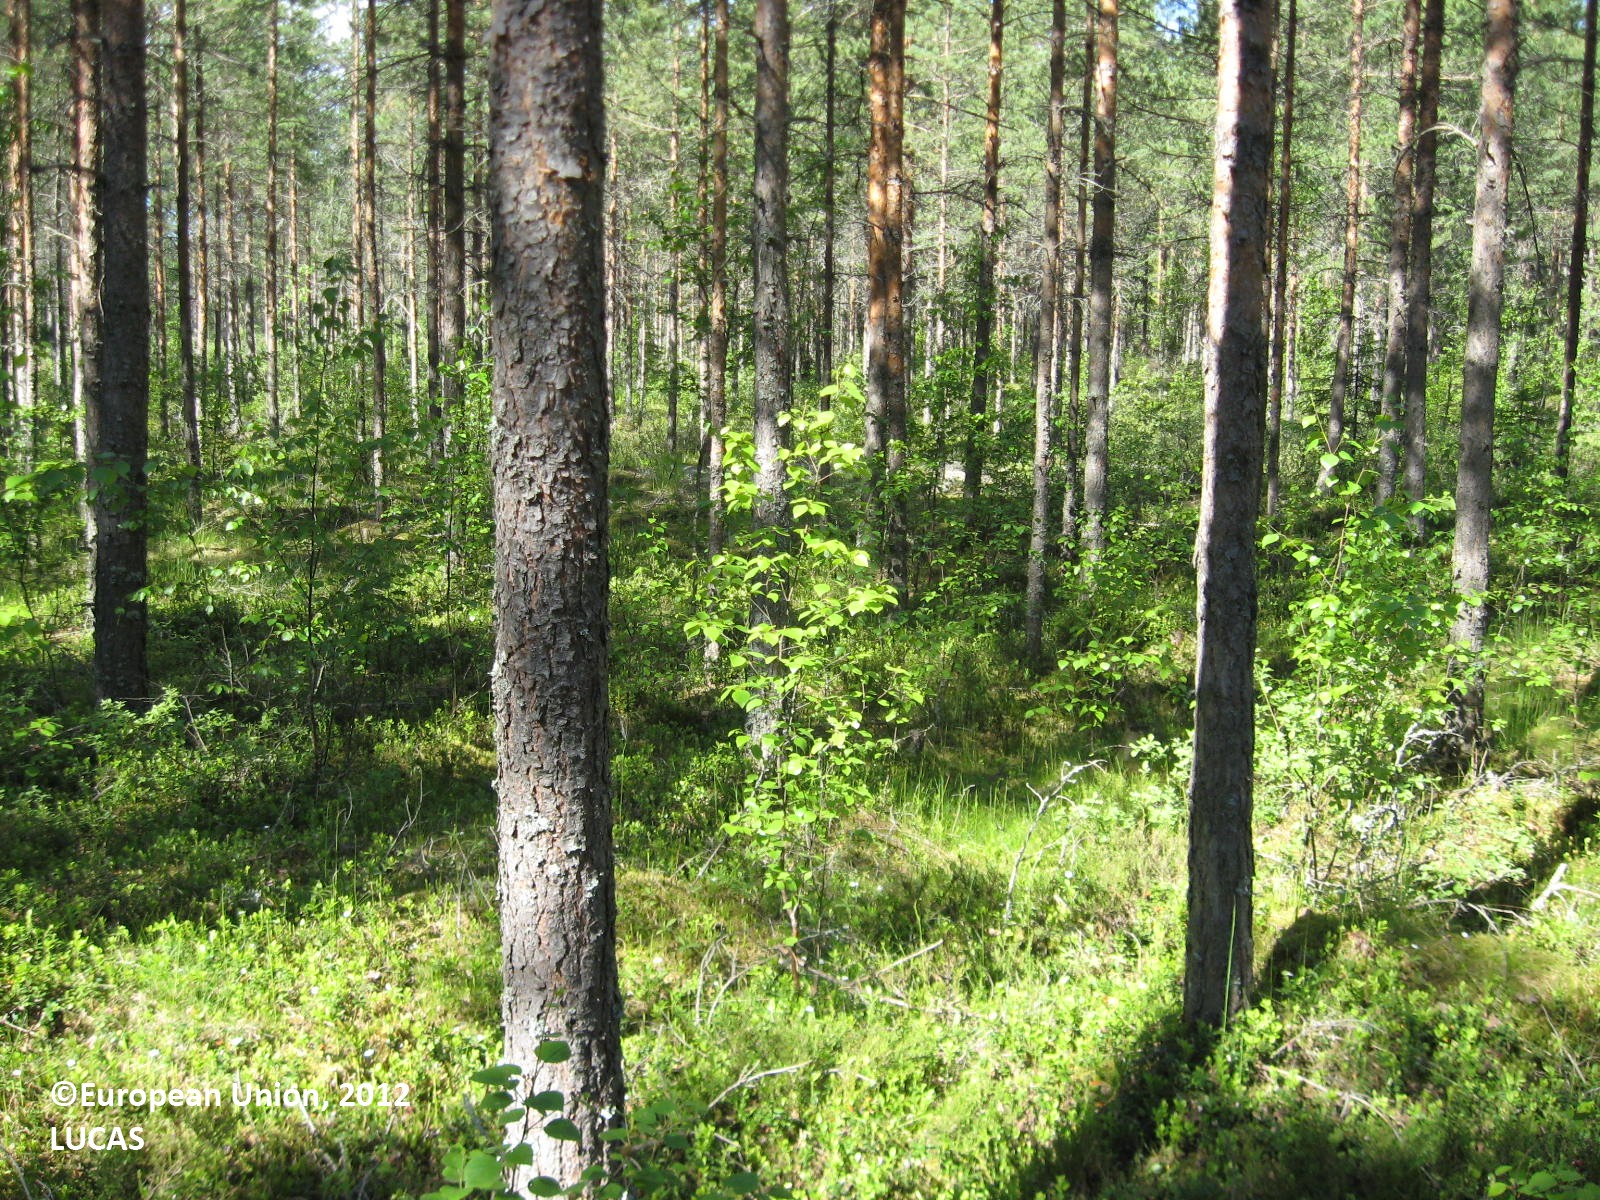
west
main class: Woodland
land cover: Pine dominated coniferous woodland
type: boreal forest
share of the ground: > 75 %
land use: Forestry
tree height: > 5 m
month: June
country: FI
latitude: 62.8317
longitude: 21.6839
